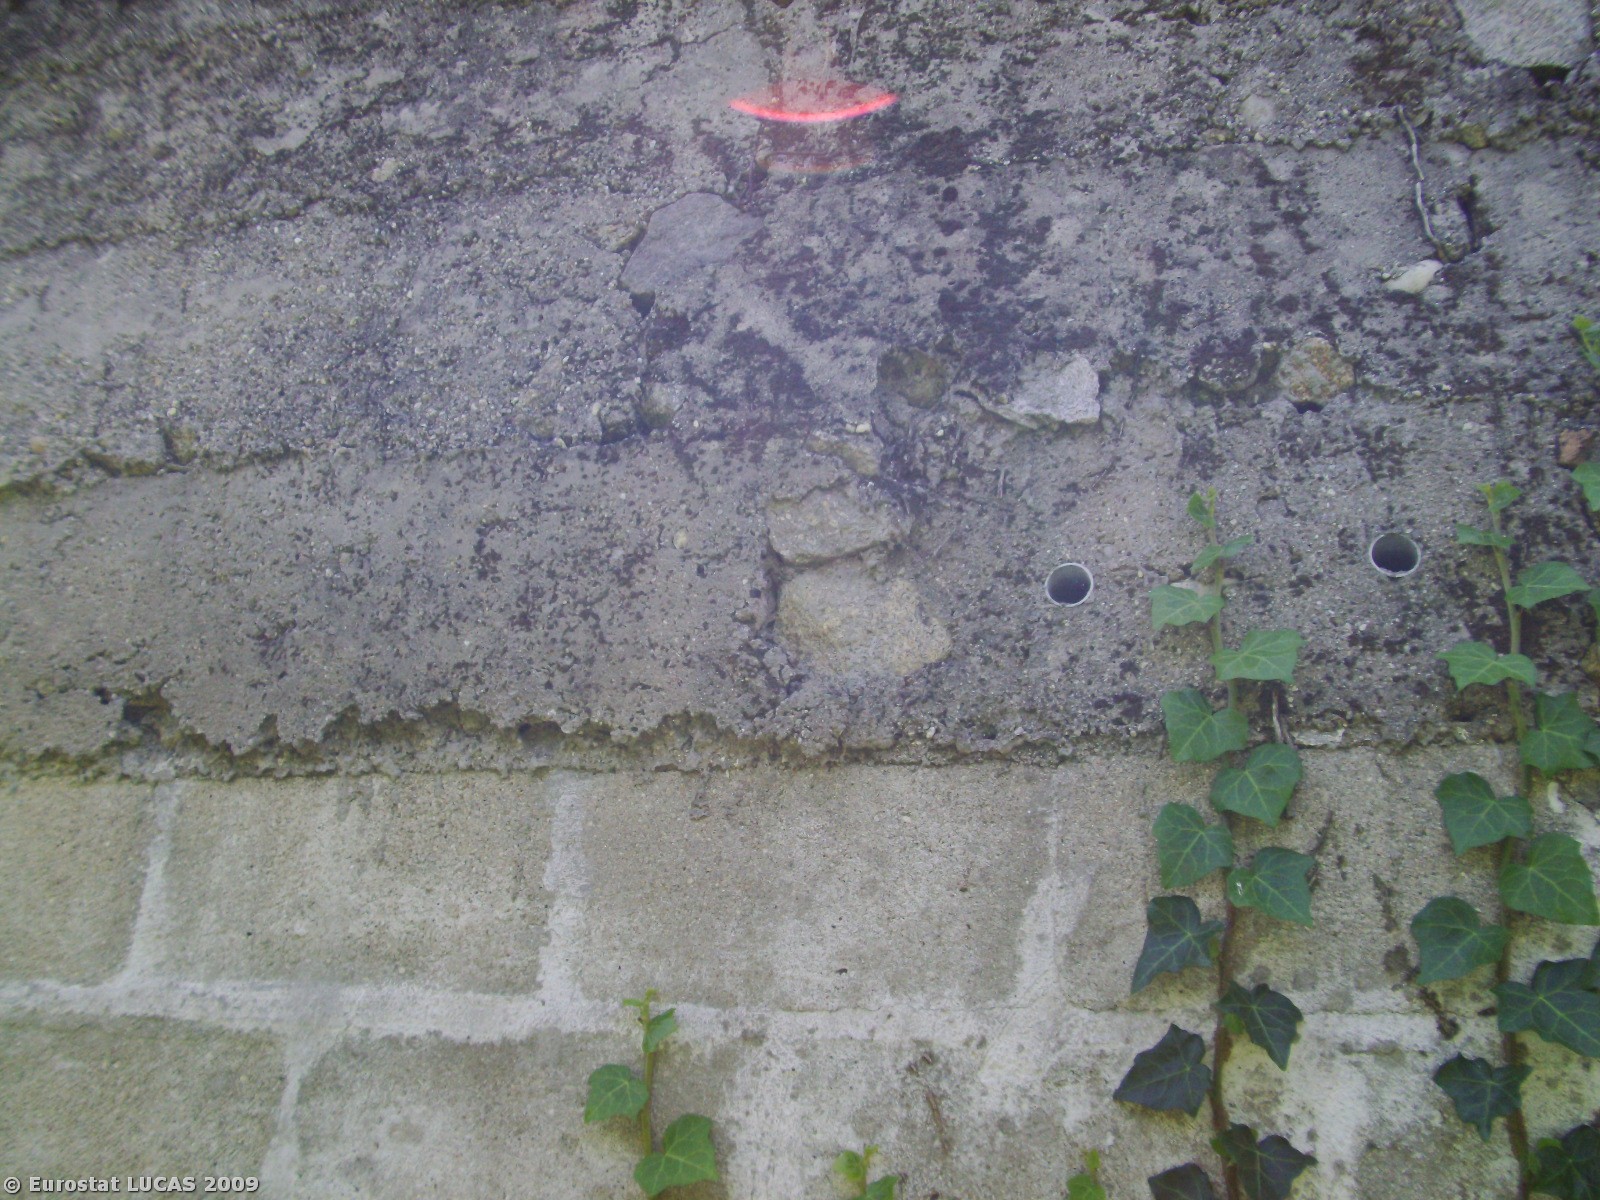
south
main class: Shrubland
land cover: Shrubland with sparse tree cover
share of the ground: > 75 %
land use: Unused
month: July
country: PT
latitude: 41.7100
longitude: -8.7838
